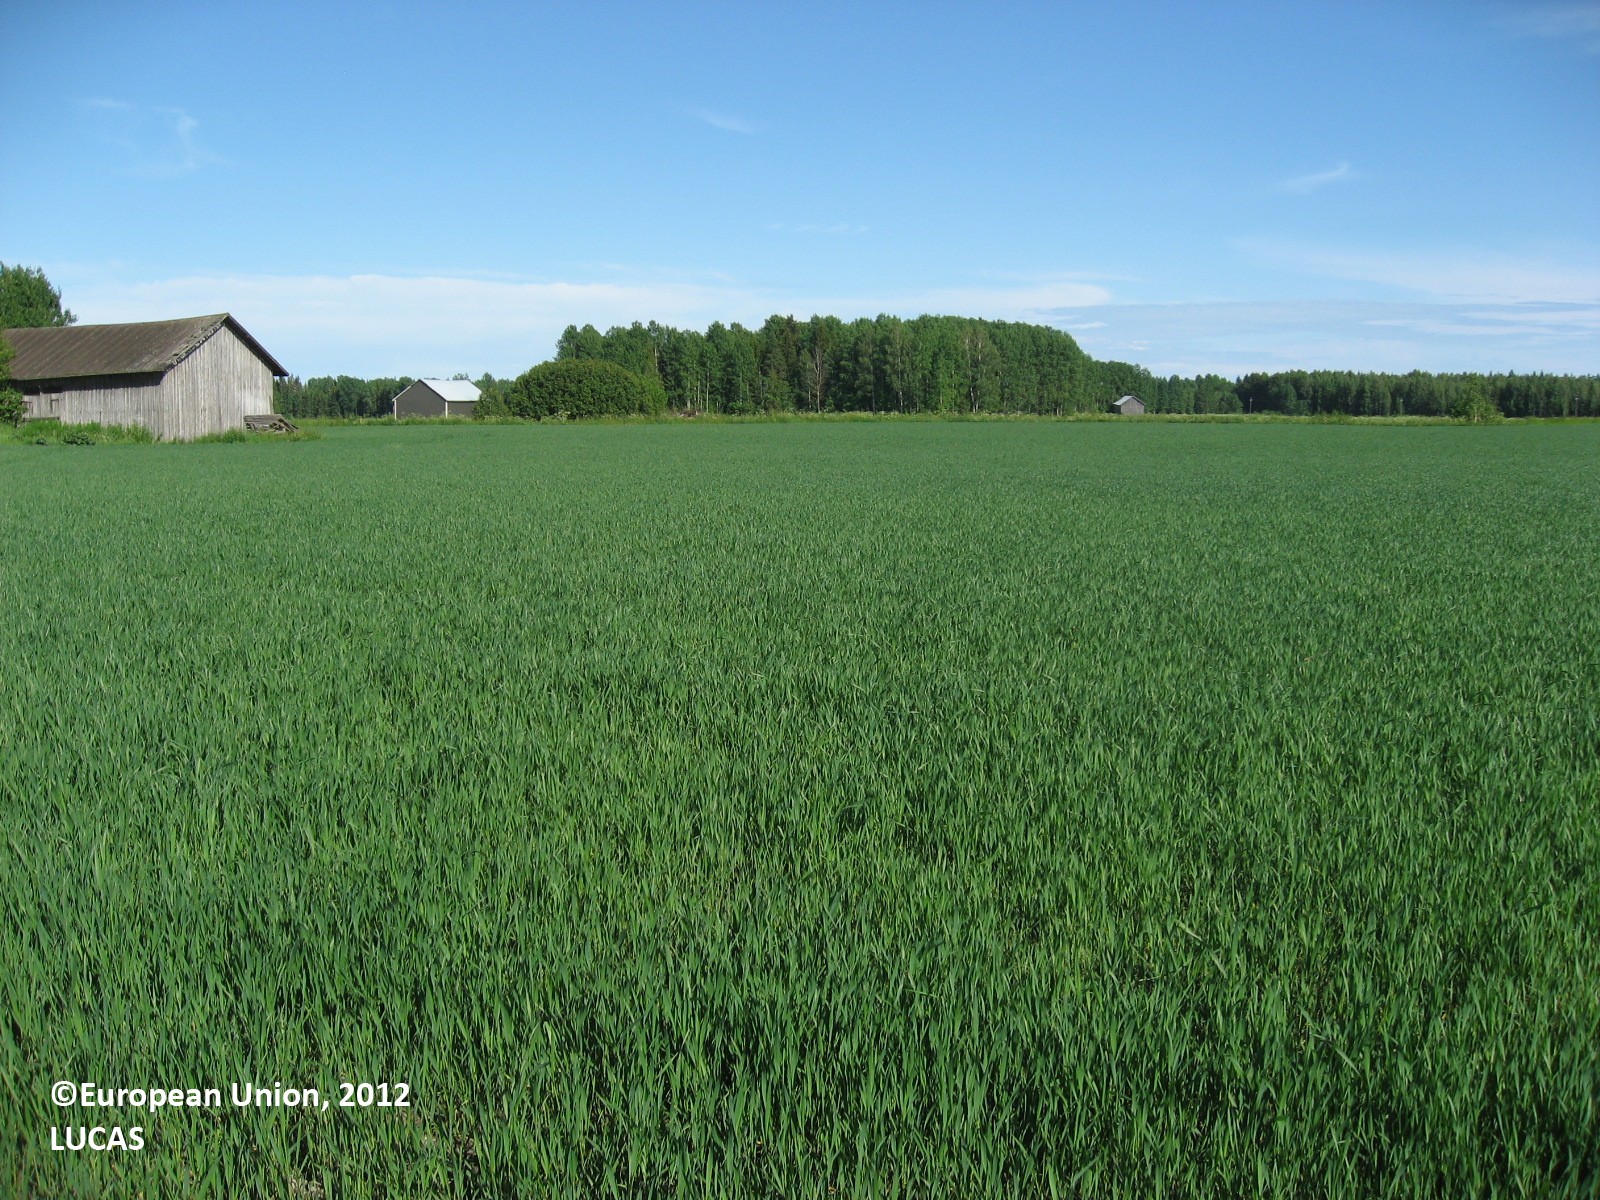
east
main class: Cropland
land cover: Common wheat
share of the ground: 50 - 75 %
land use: Agriculture (excluding fallow land and kitchen gardens)
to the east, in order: Common wheat
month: June
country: FI
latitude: 60.5871
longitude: 26.3051
